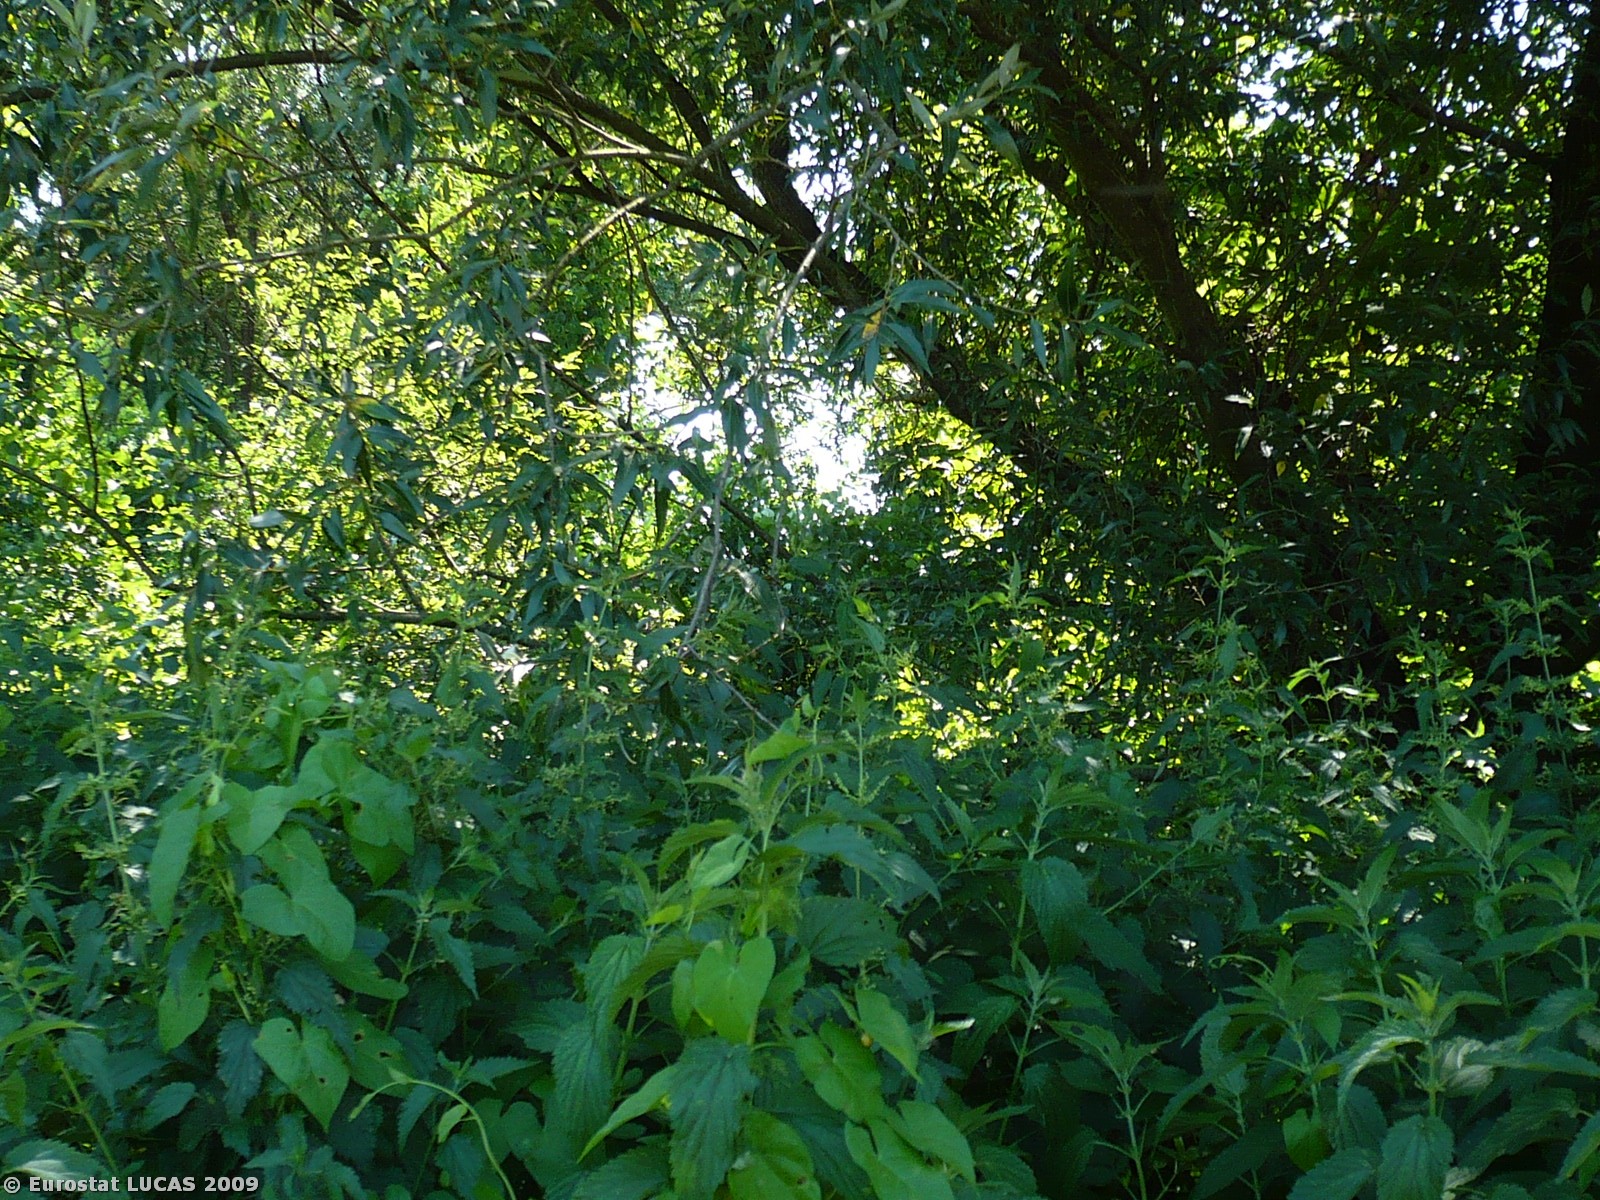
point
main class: Woodland
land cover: Broadleaved woodland
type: floodplain forest
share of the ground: > 75 %
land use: Unused
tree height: > 5 m
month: July
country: SI
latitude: 46.8109
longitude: 16.0684
